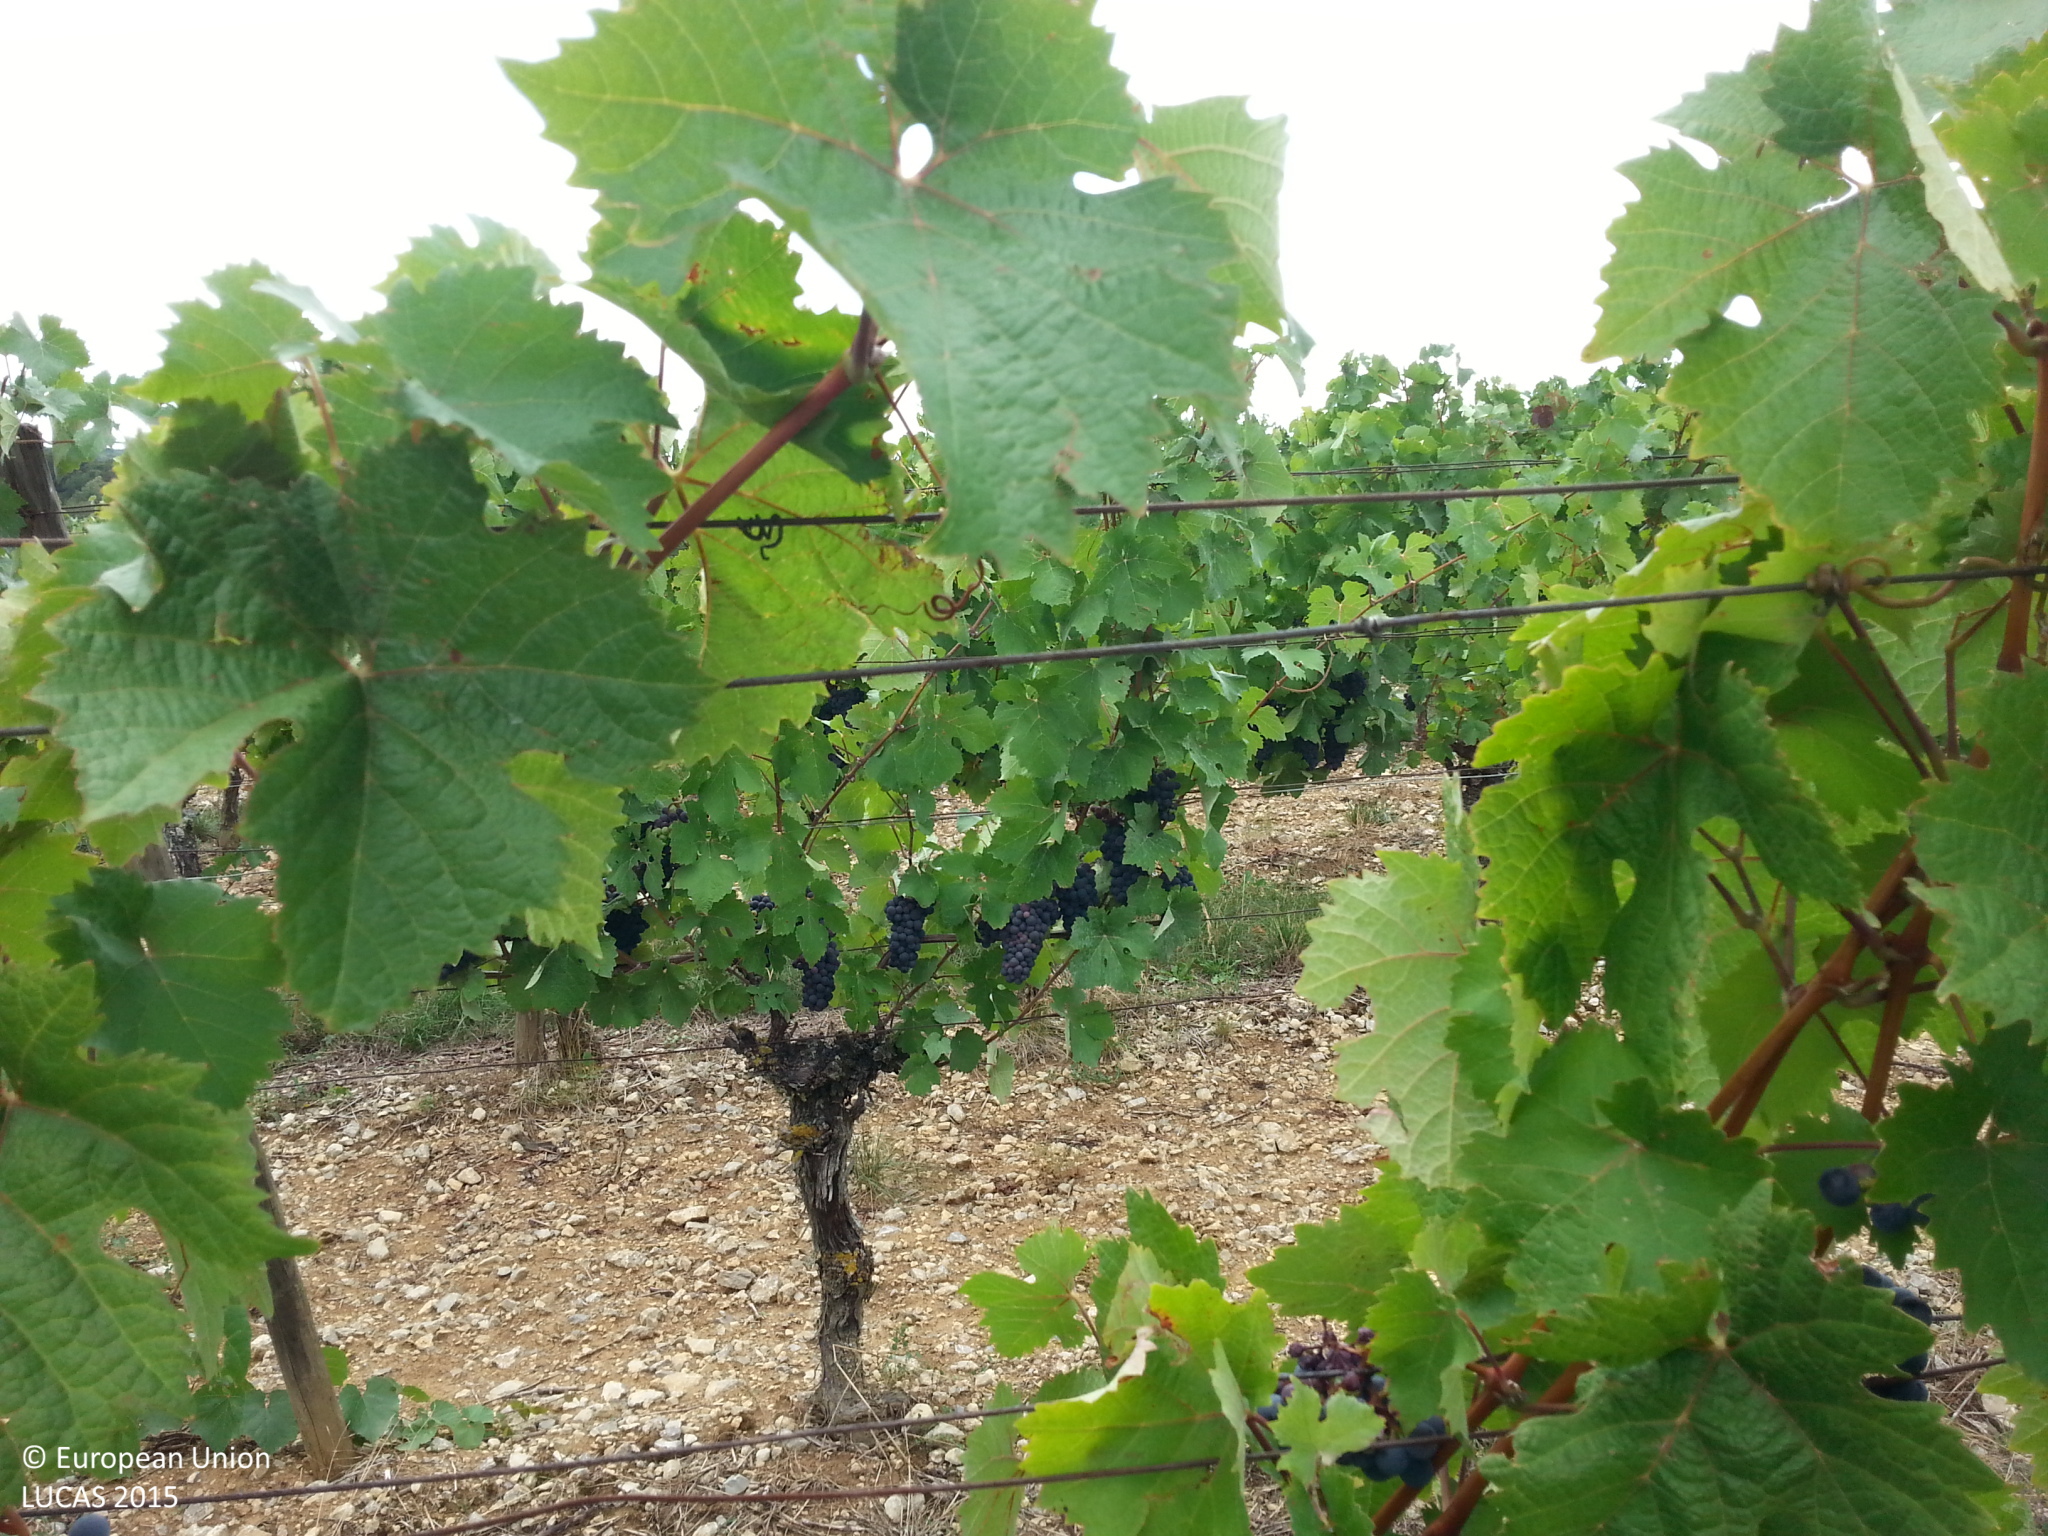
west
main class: Cropland
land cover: Vineyards
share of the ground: 50 - 75 %
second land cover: Spontaneously vegetated surfaces
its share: 10 - 25 %
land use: Agriculture (excluding fallow land and kitchen gardens)
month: September
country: DE
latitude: 49.6080
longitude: 9.5988
